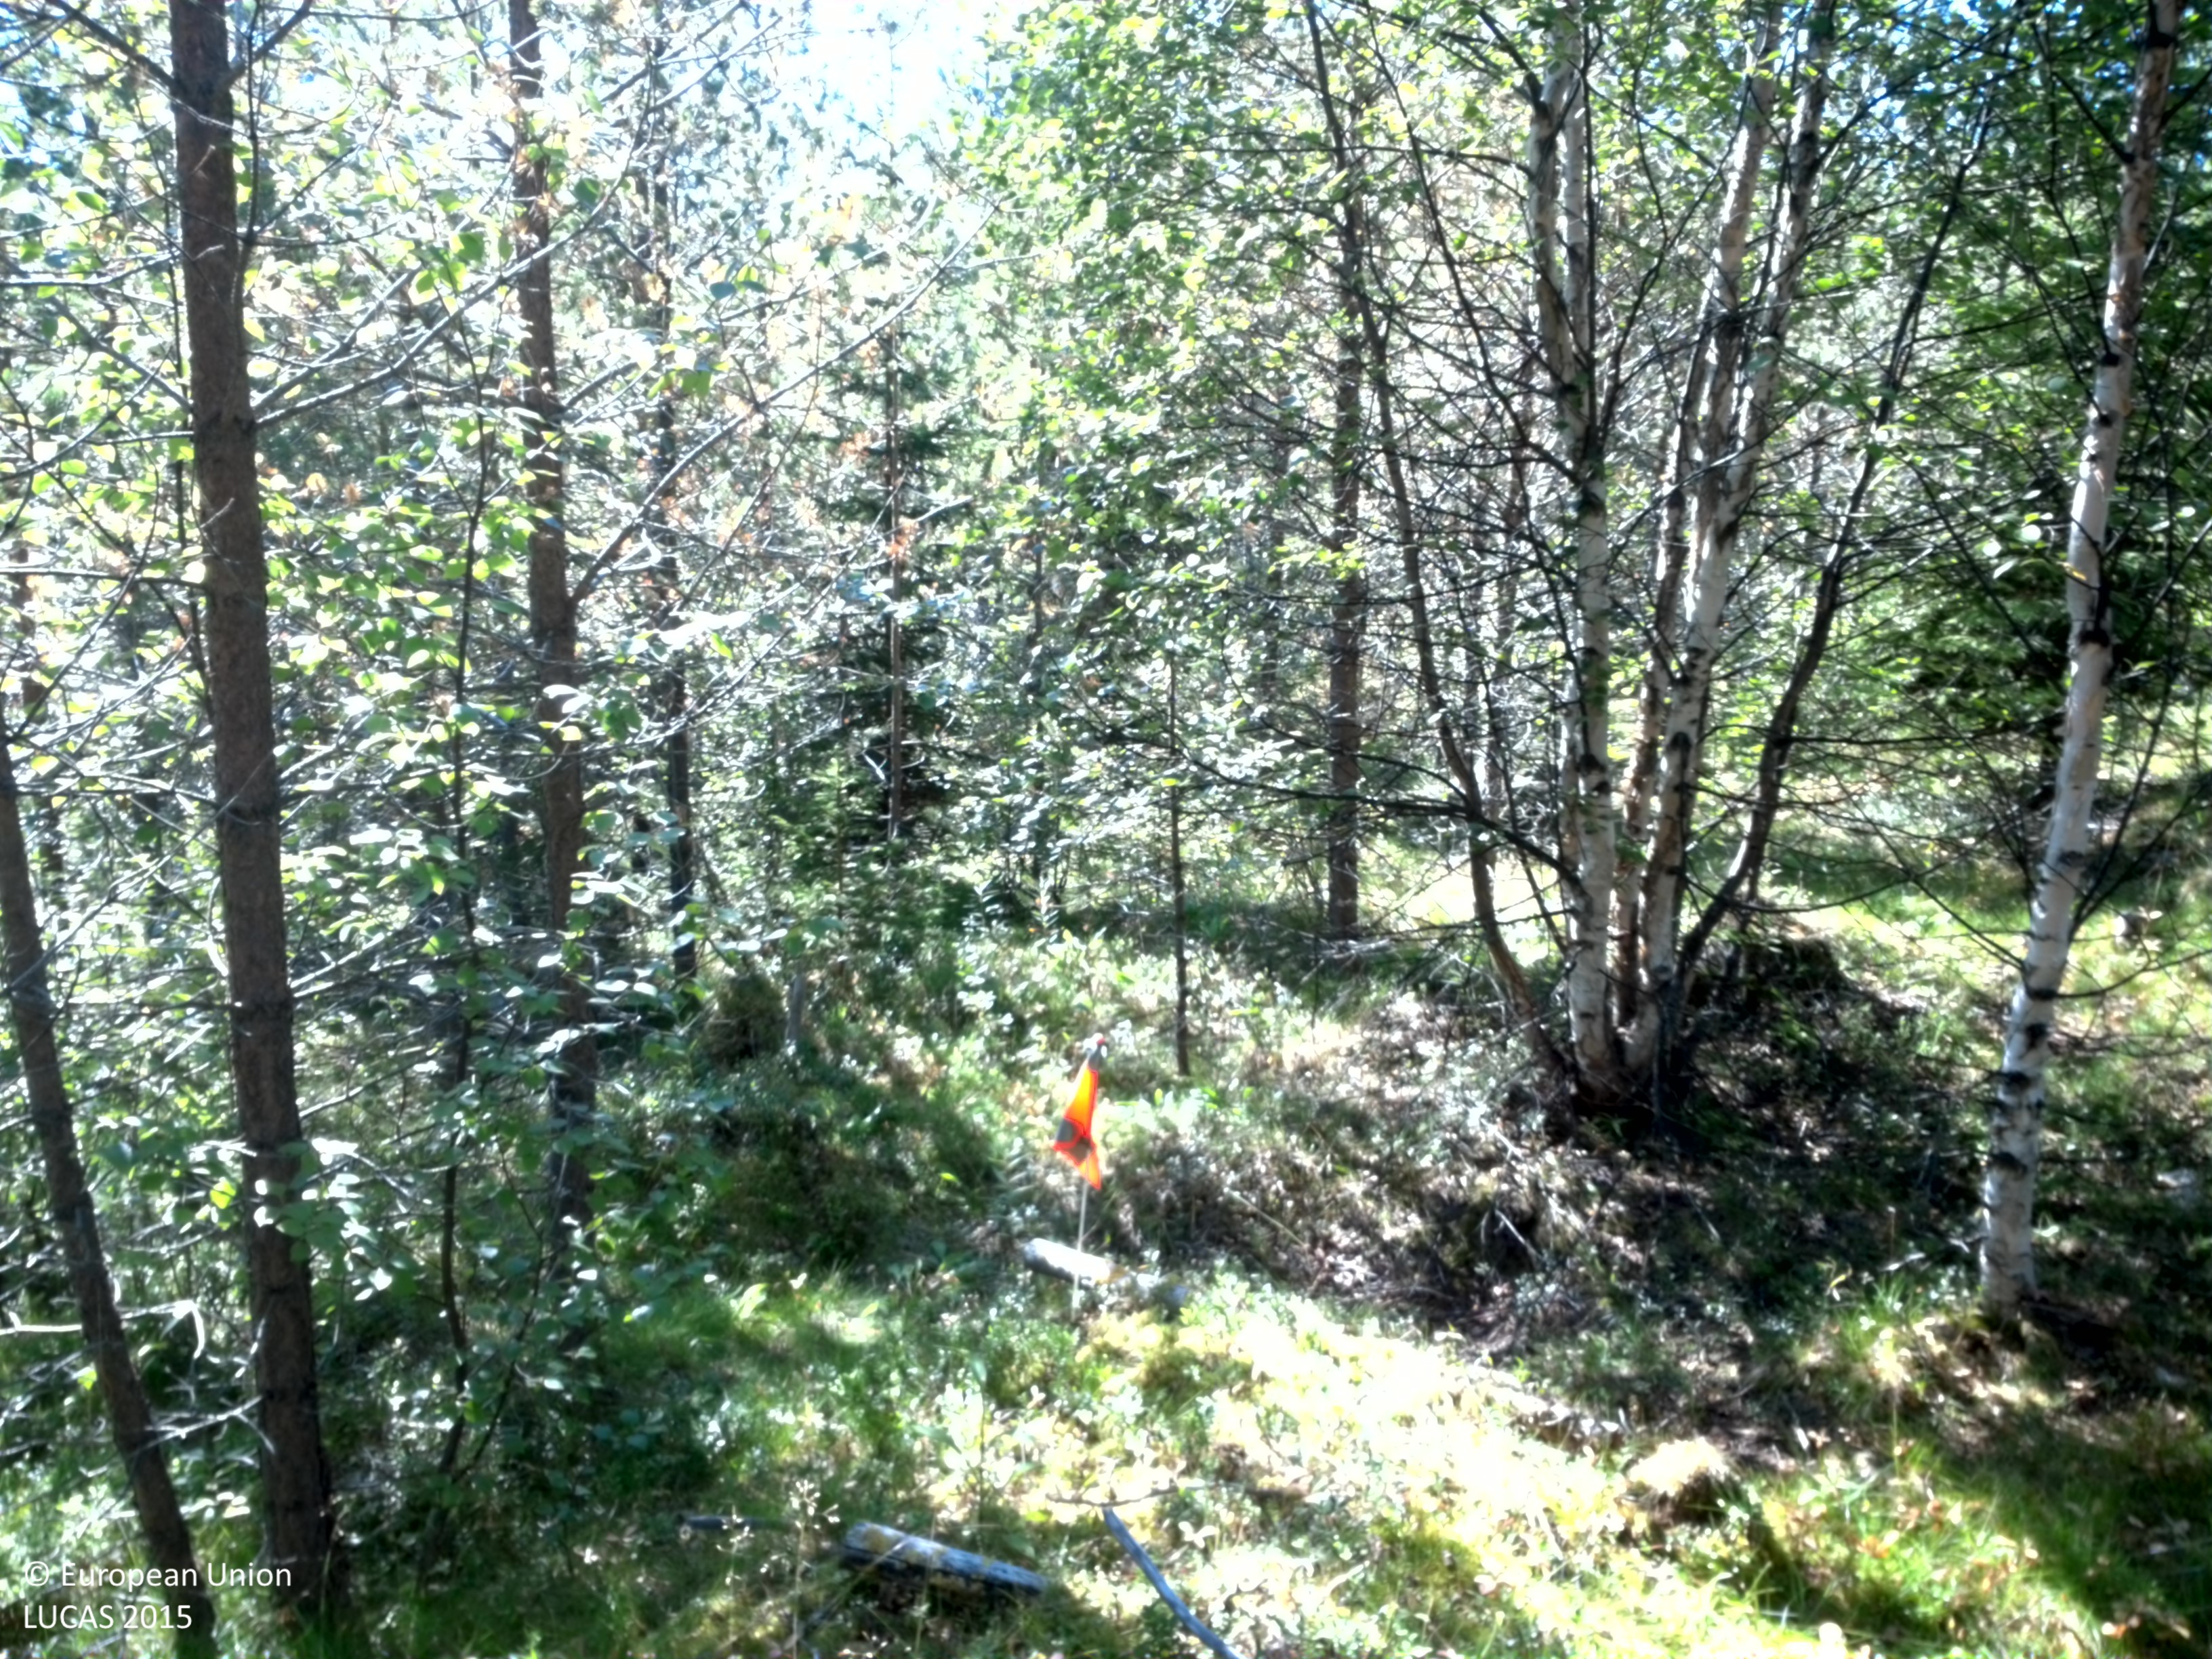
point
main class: Woodland
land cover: Pine dominated coniferous woodland
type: boreal forest
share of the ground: 50 - 75 %
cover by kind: coniferous forest trees 50 %, herbaceous plants 20 %, shrubs 15 %, lichens and mosses 10 %, broadleaved forest trees 5 %
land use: Forestry
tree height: > 5 m
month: August
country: SE
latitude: 64.7902
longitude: 16.0481
